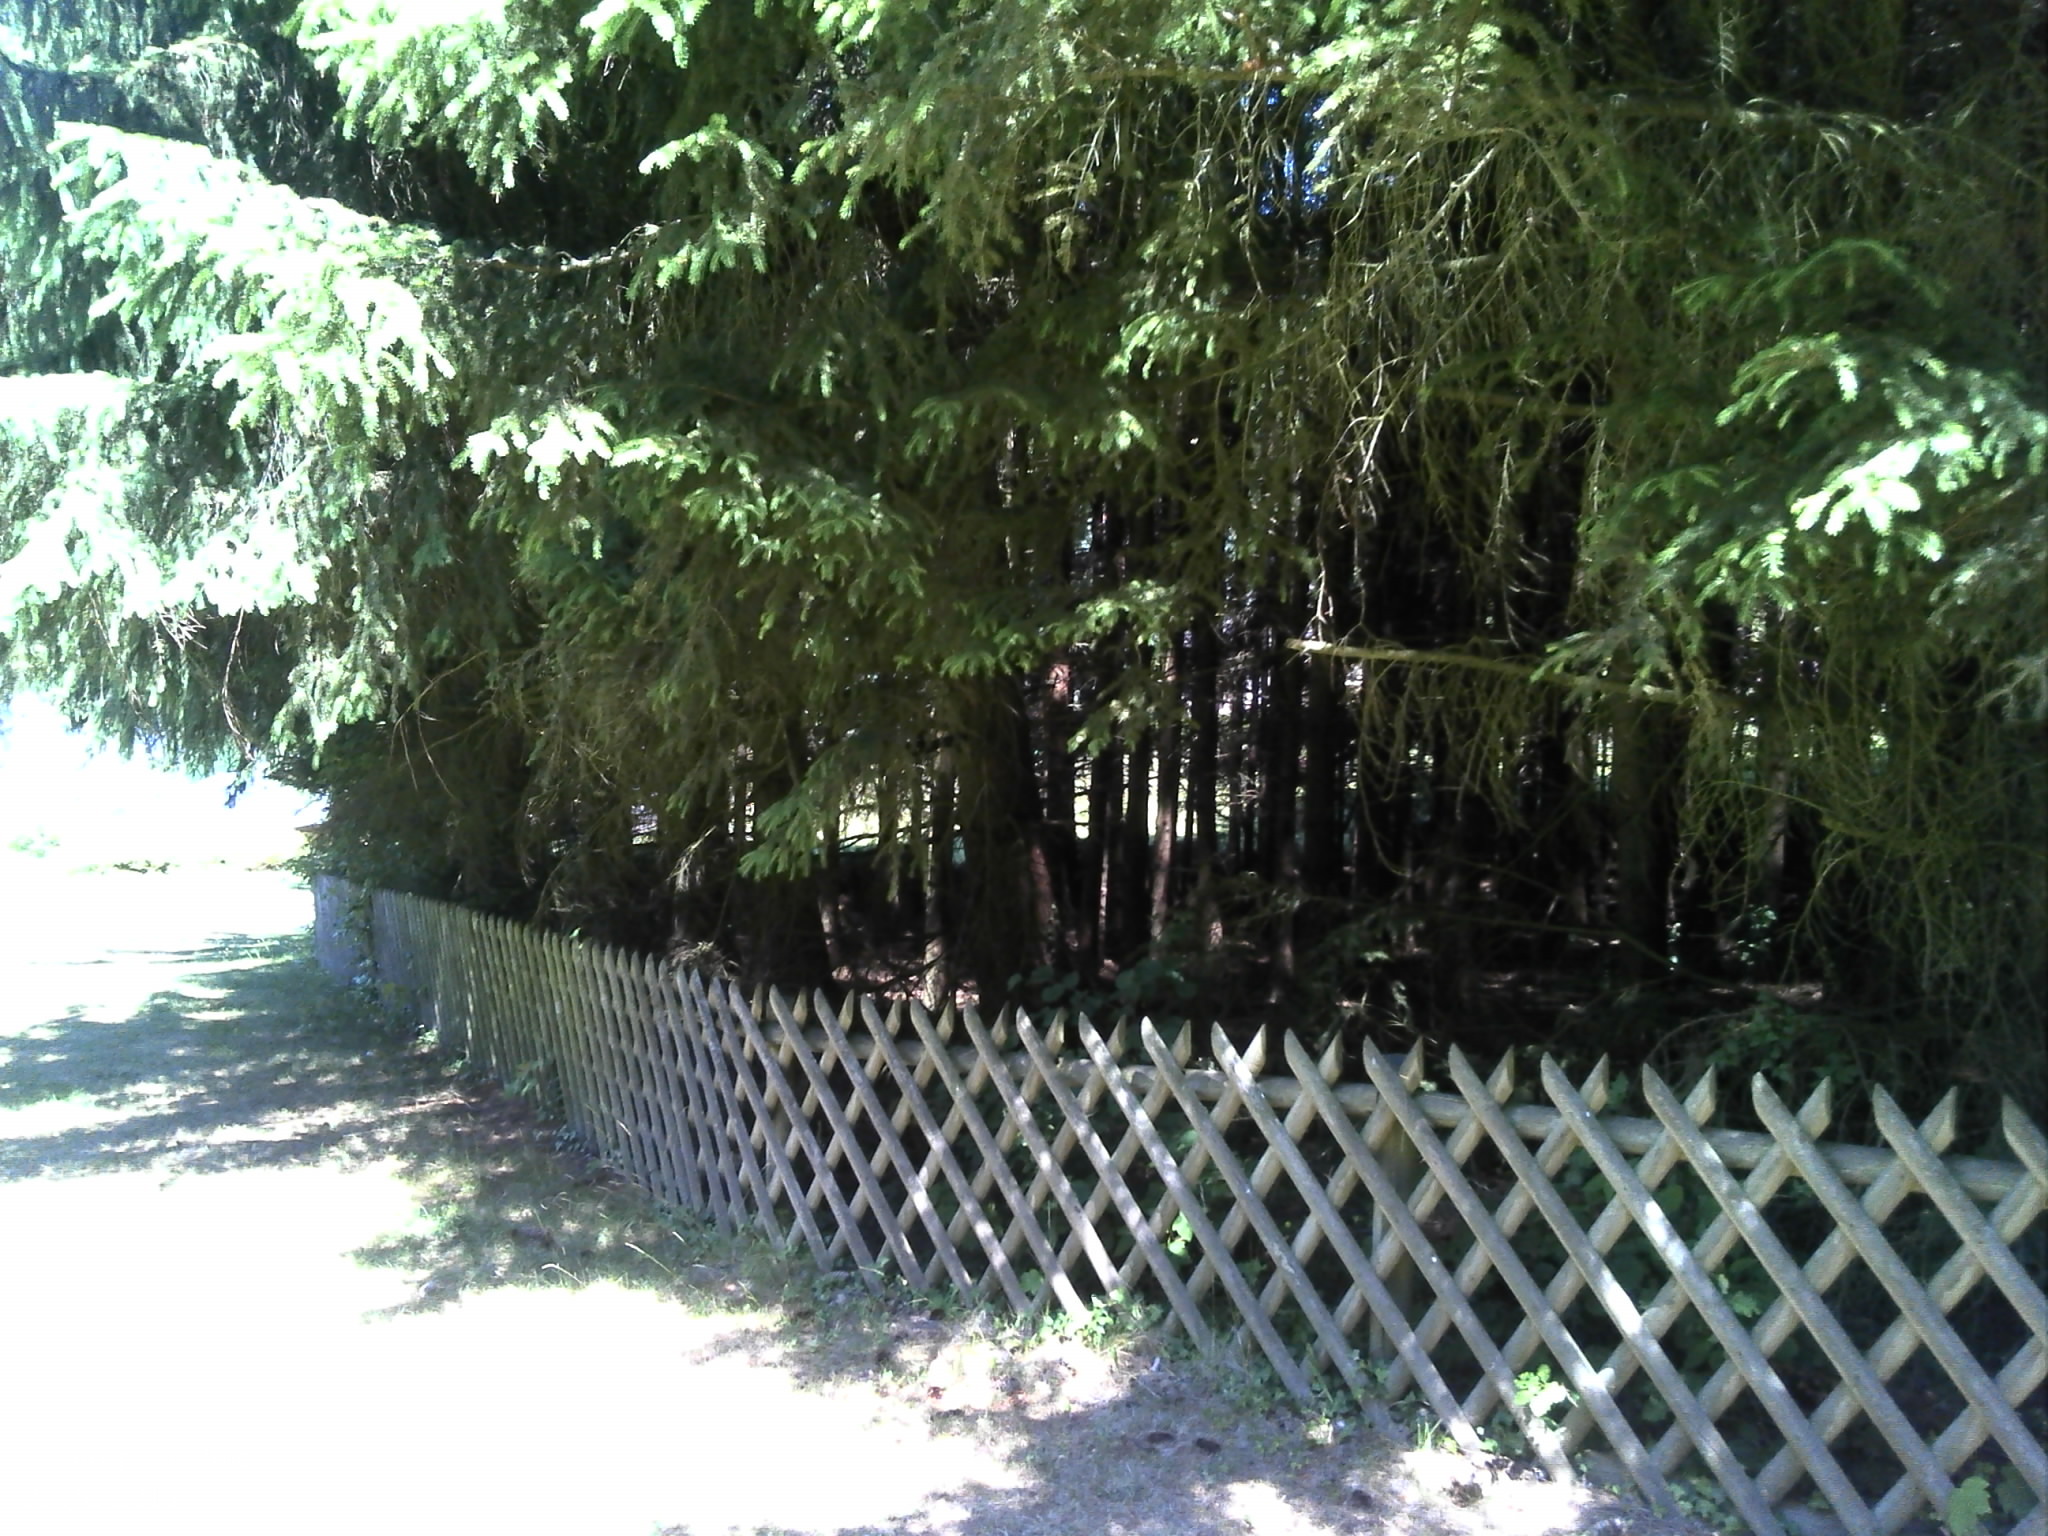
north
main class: Grassland
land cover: Grassland without tree/shrub cover
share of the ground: > 75 %
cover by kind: herbaceous plants 100 %
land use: Residential
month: June
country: FR
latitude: 49.3785
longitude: 6.0739
